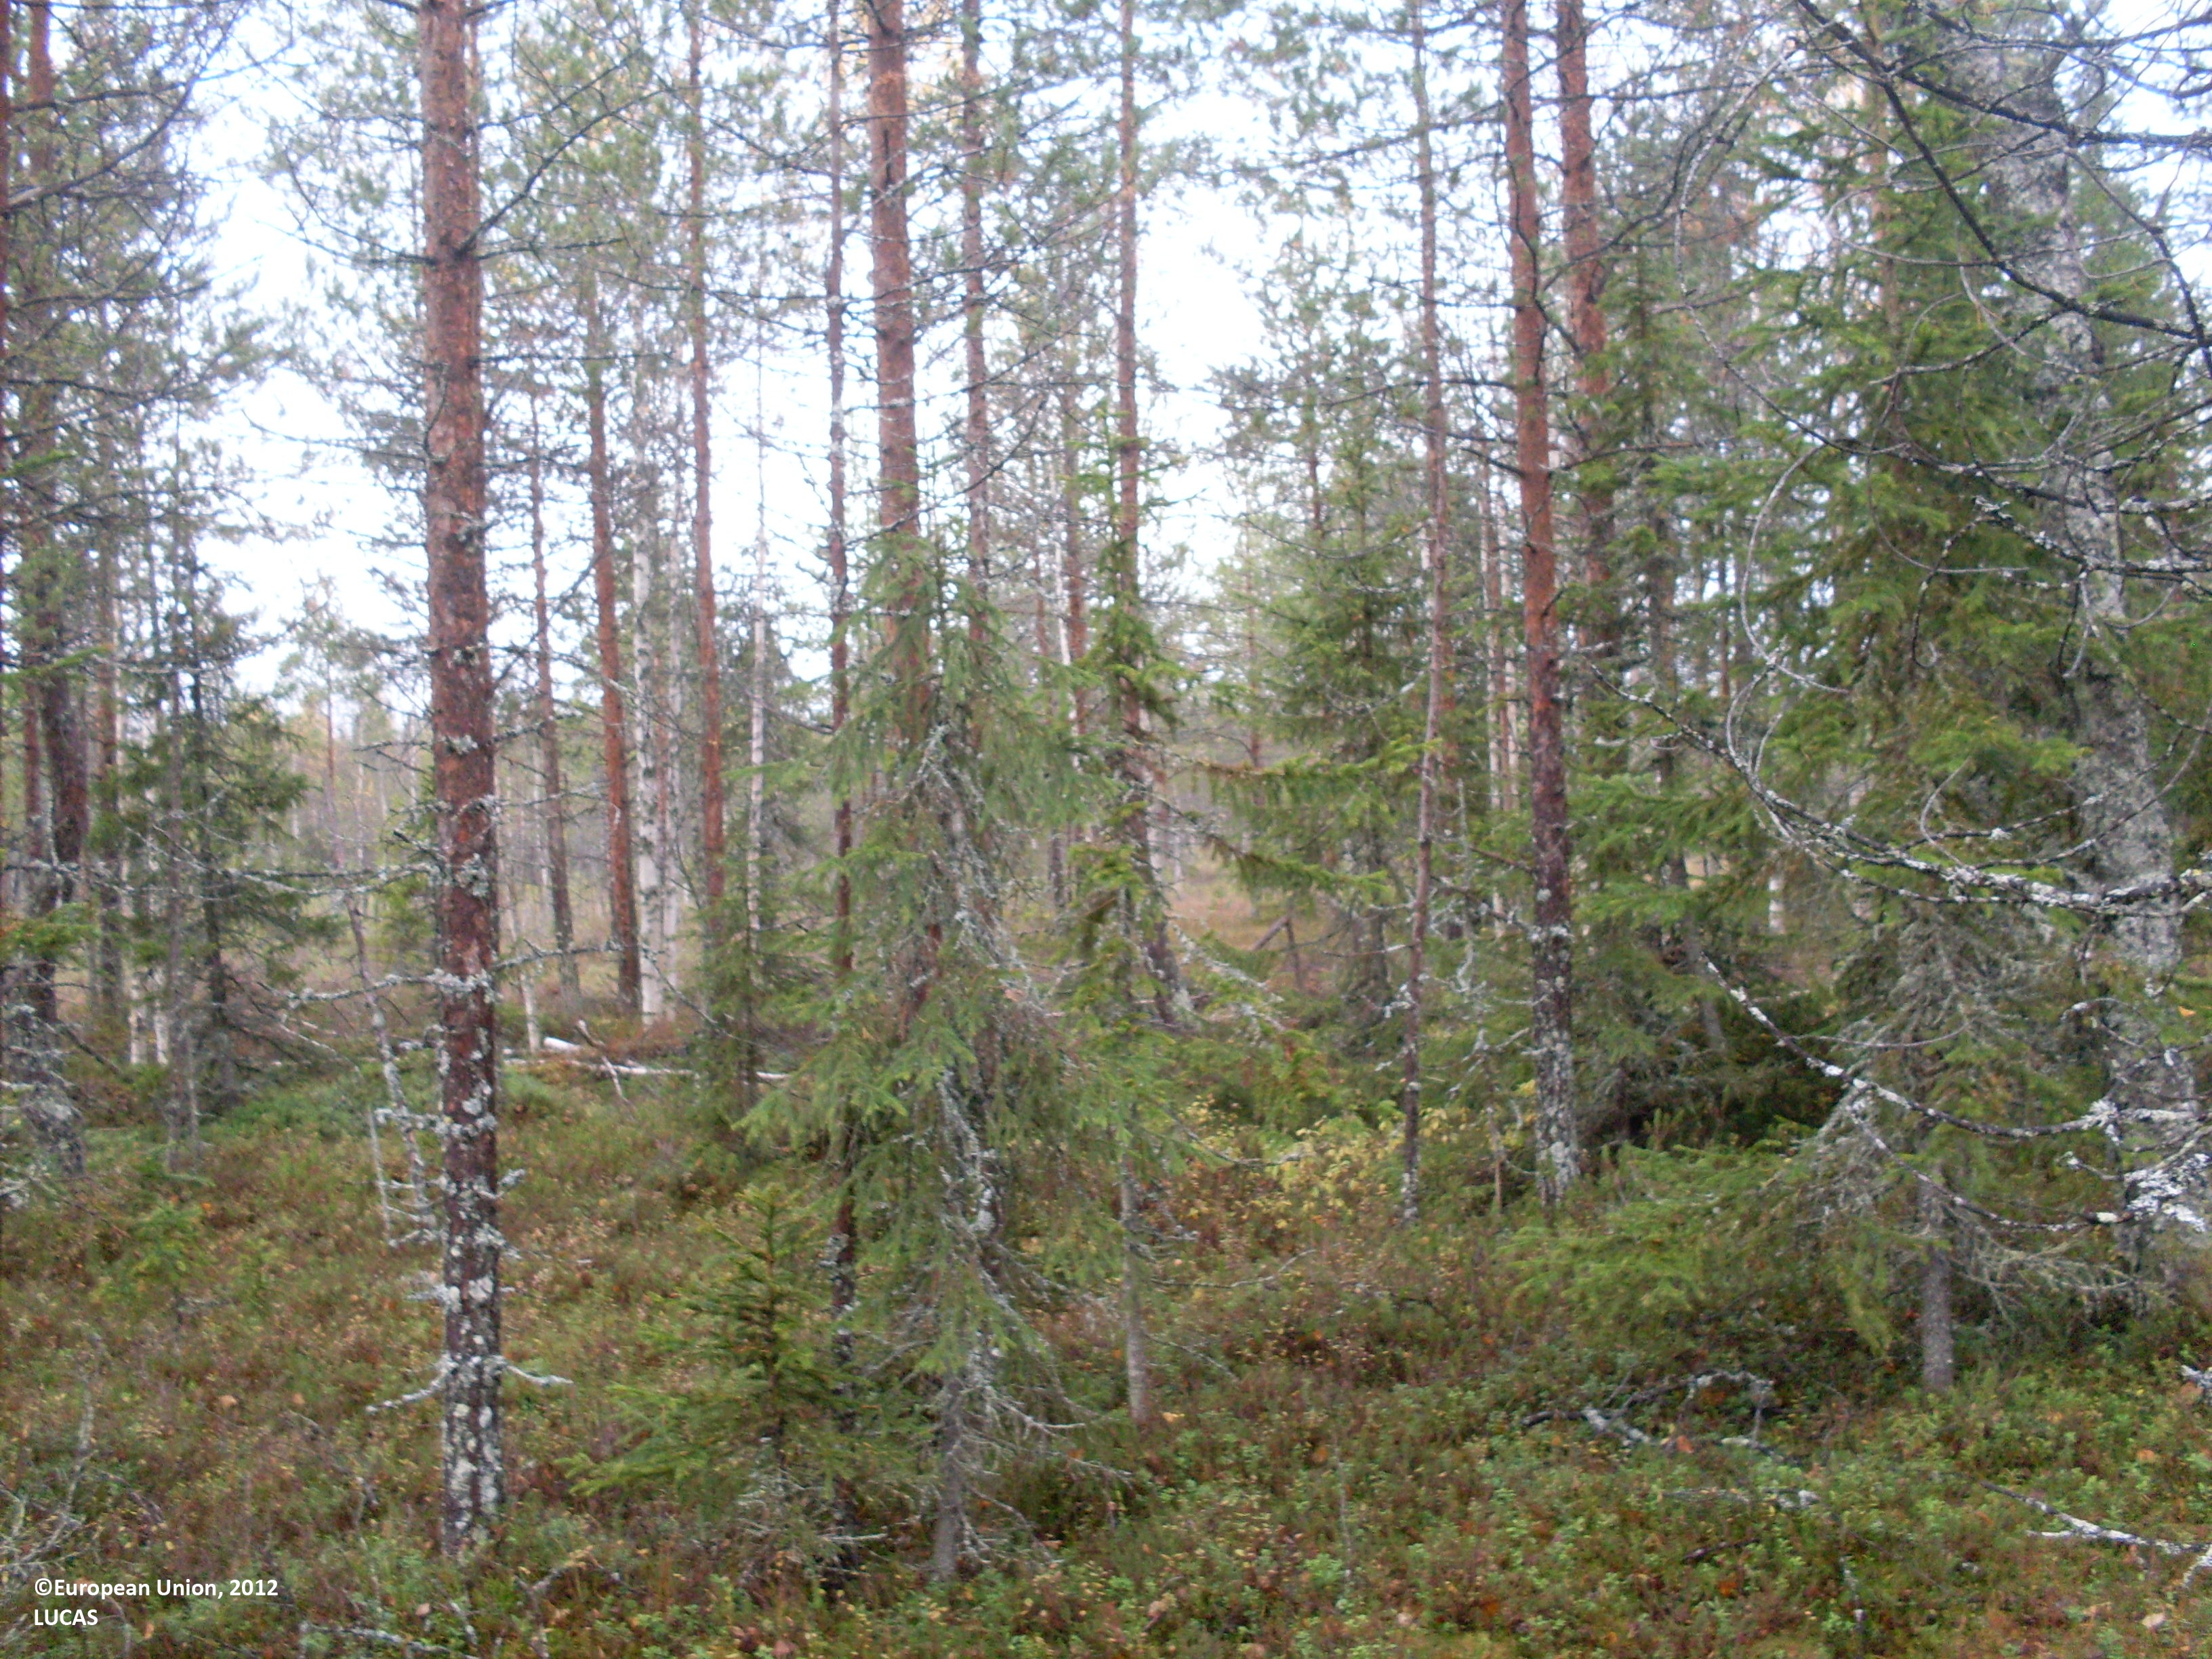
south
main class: Woodland
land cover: Pine dominated mixed woodland
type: boreal forest
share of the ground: 25 - 50 %
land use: Forestry
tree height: > 5 m
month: September
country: FI
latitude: 64.4616
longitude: 28.5779
